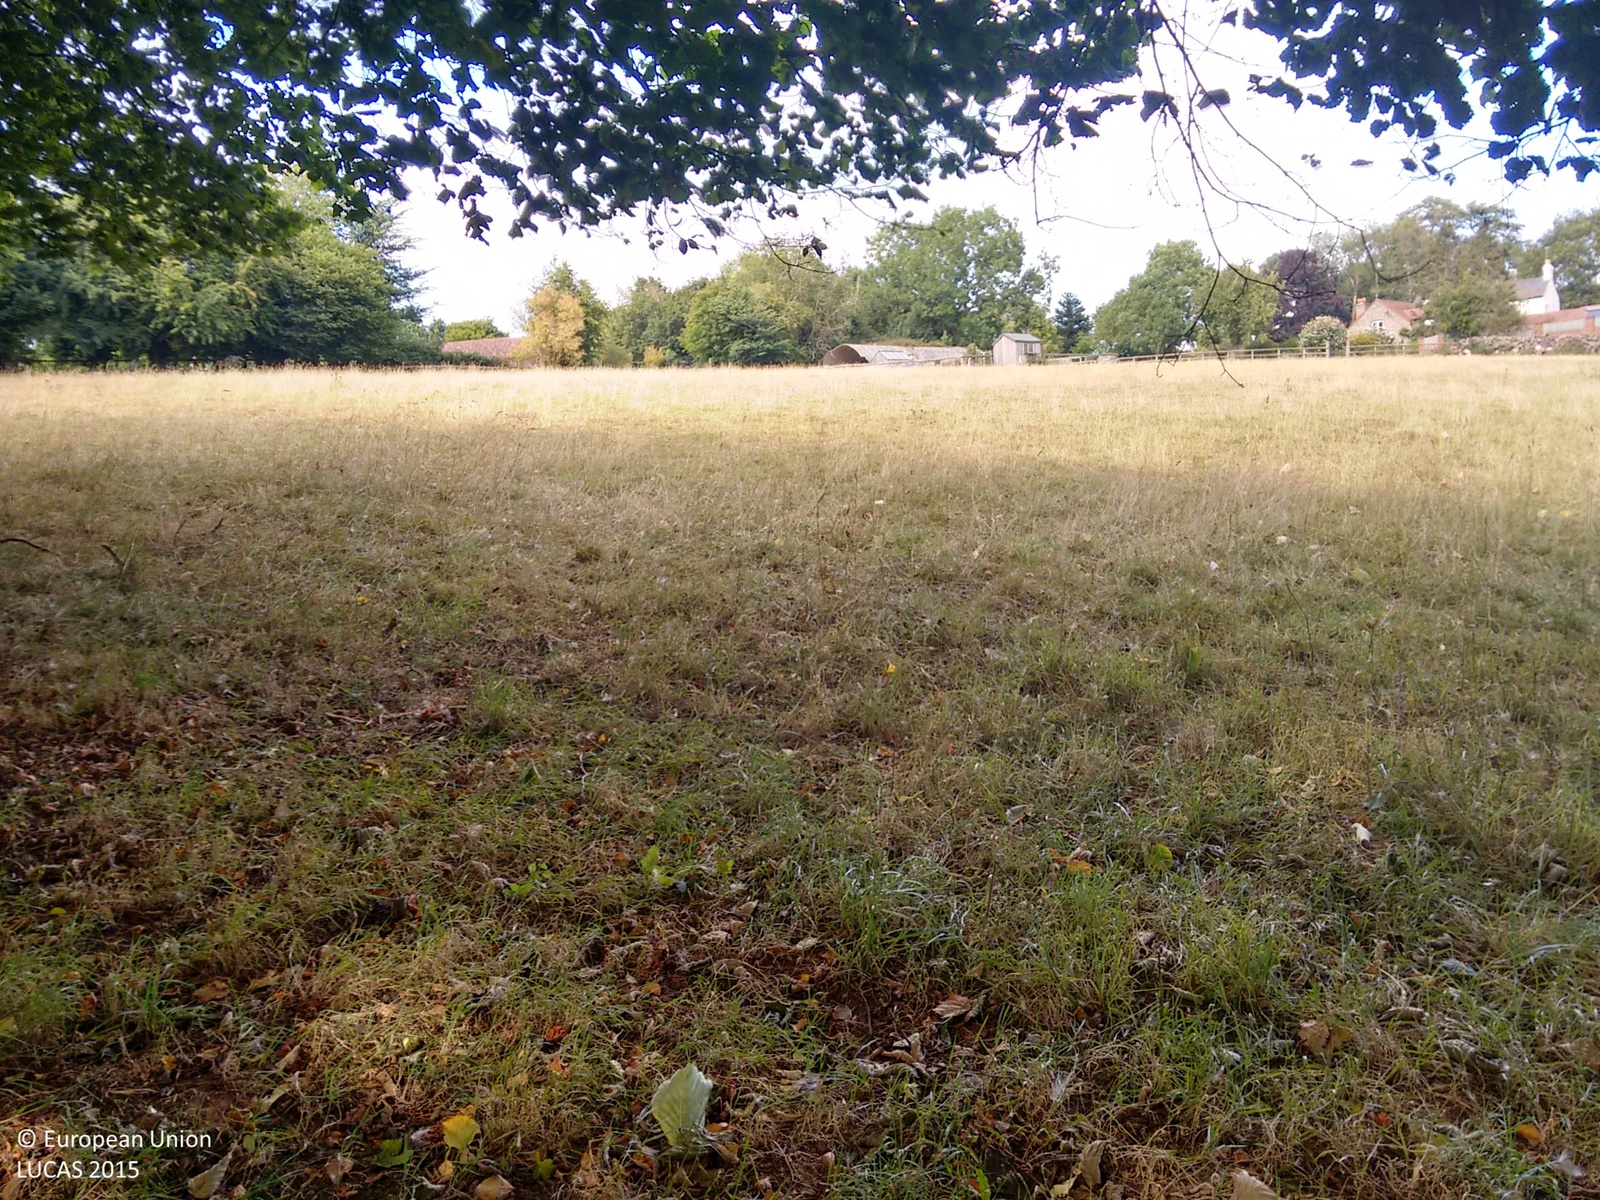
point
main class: Grassland
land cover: Grassland without tree/shrub cover
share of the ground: > 75 %
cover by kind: herbaceous plants 100 %
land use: Agriculture (excluding fallow land and kitchen gardens)
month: August
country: GB
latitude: 51.8924
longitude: -2.6972
